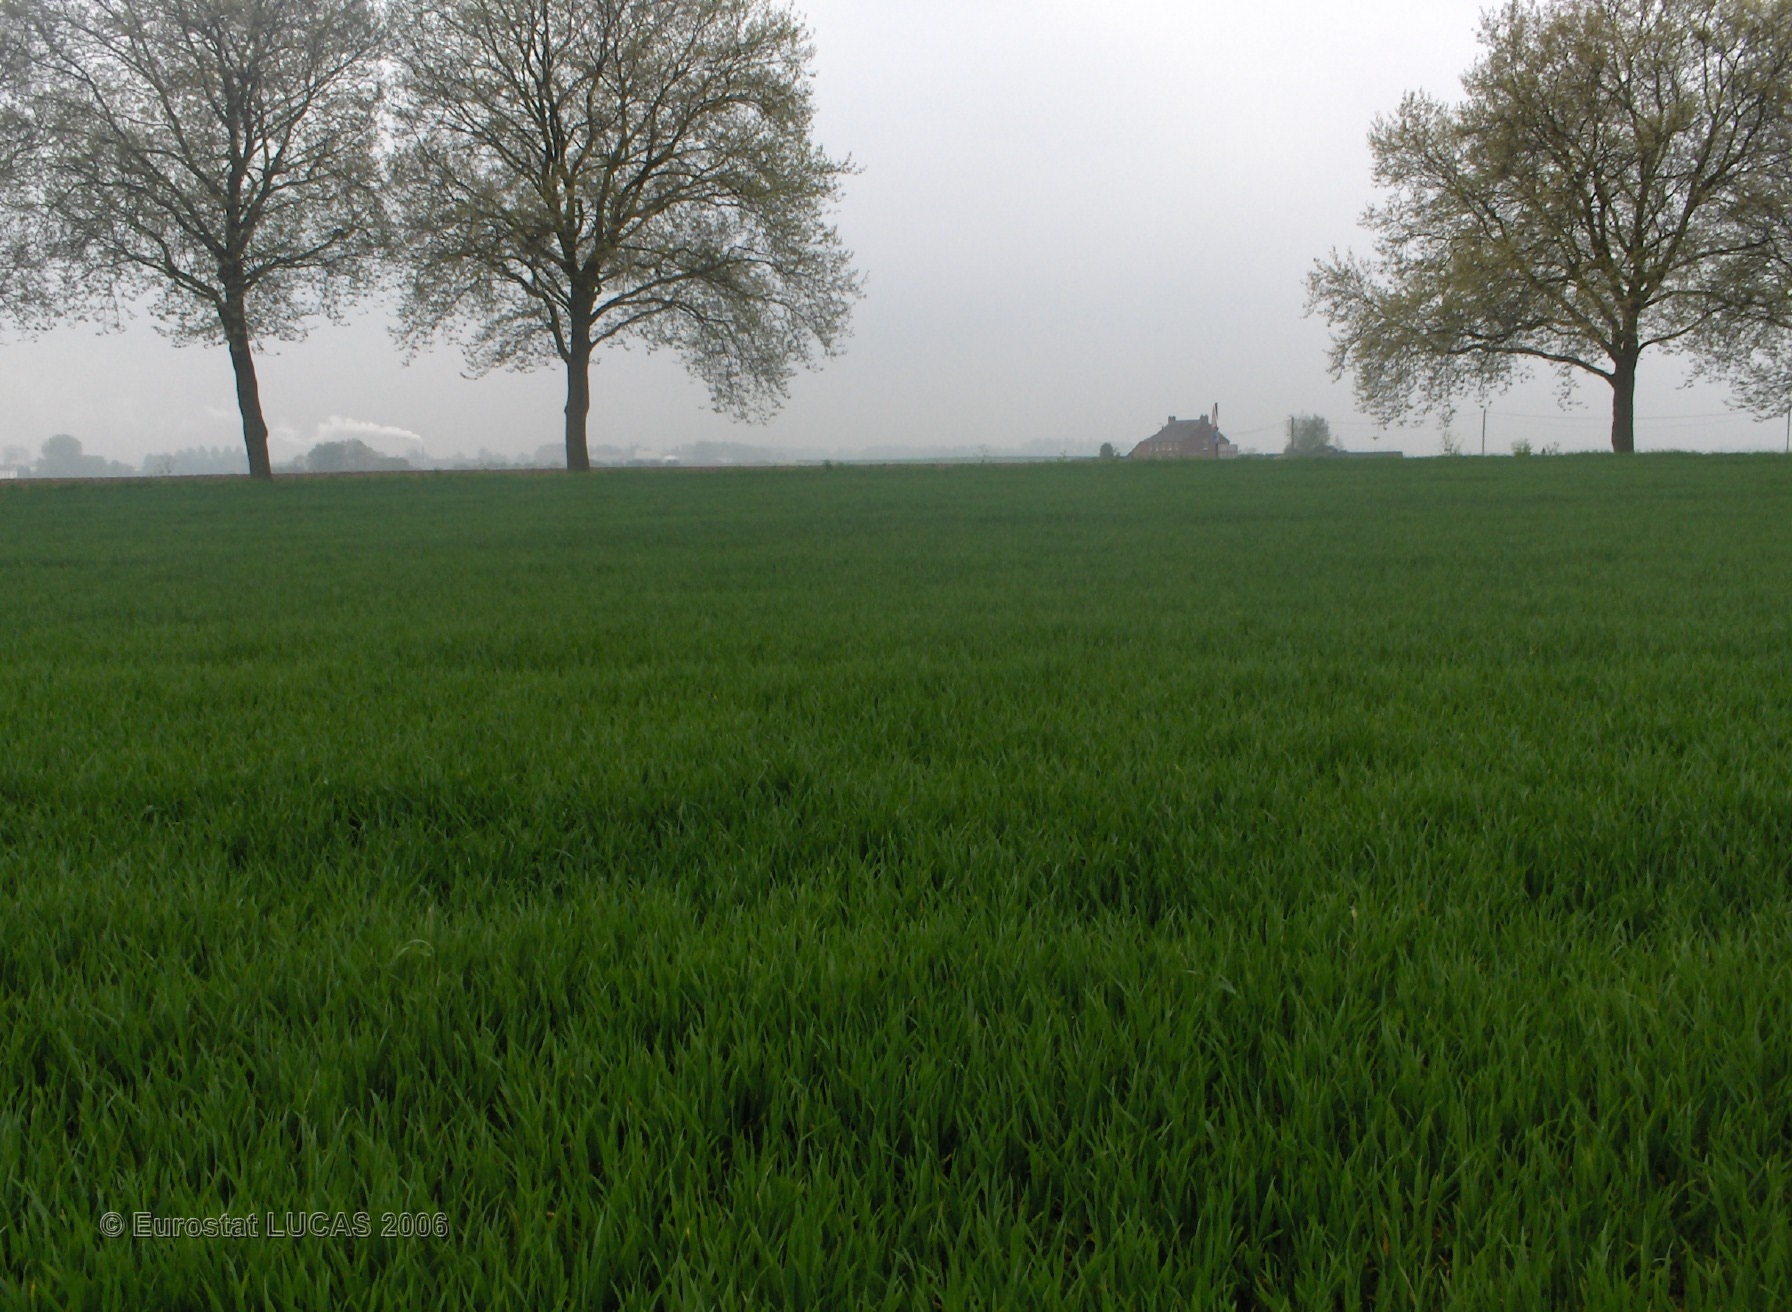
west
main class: Cropland
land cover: Common wheat
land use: Agriculture (excluding fallow land and kitchen gardens)
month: May
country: BE
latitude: 50.5399
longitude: 4.5353
